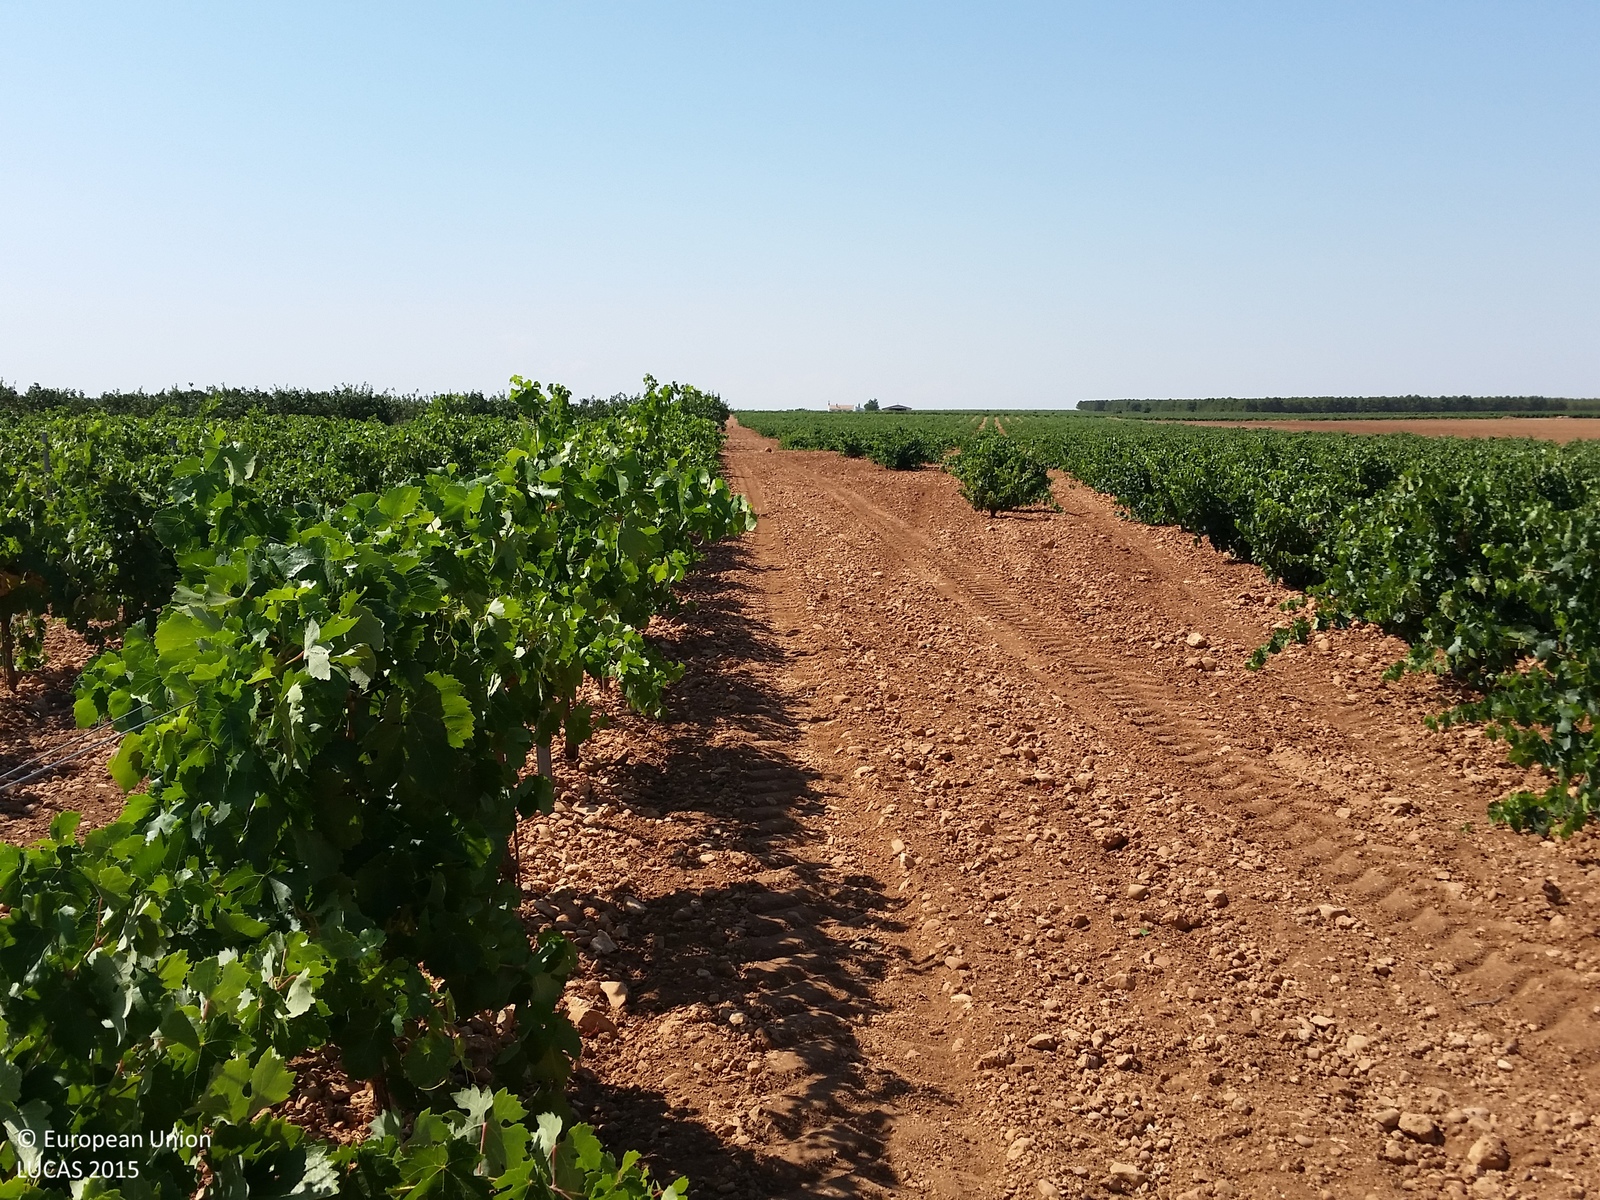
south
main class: Cropland
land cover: Vineyards
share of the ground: 50 - 75 %
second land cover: Other bare soil
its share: > 75 %
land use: Agriculture (excluding fallow land and kitchen gardens)
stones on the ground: 10 - 25 %
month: July
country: ES
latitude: 39.2168
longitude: -2.5758
